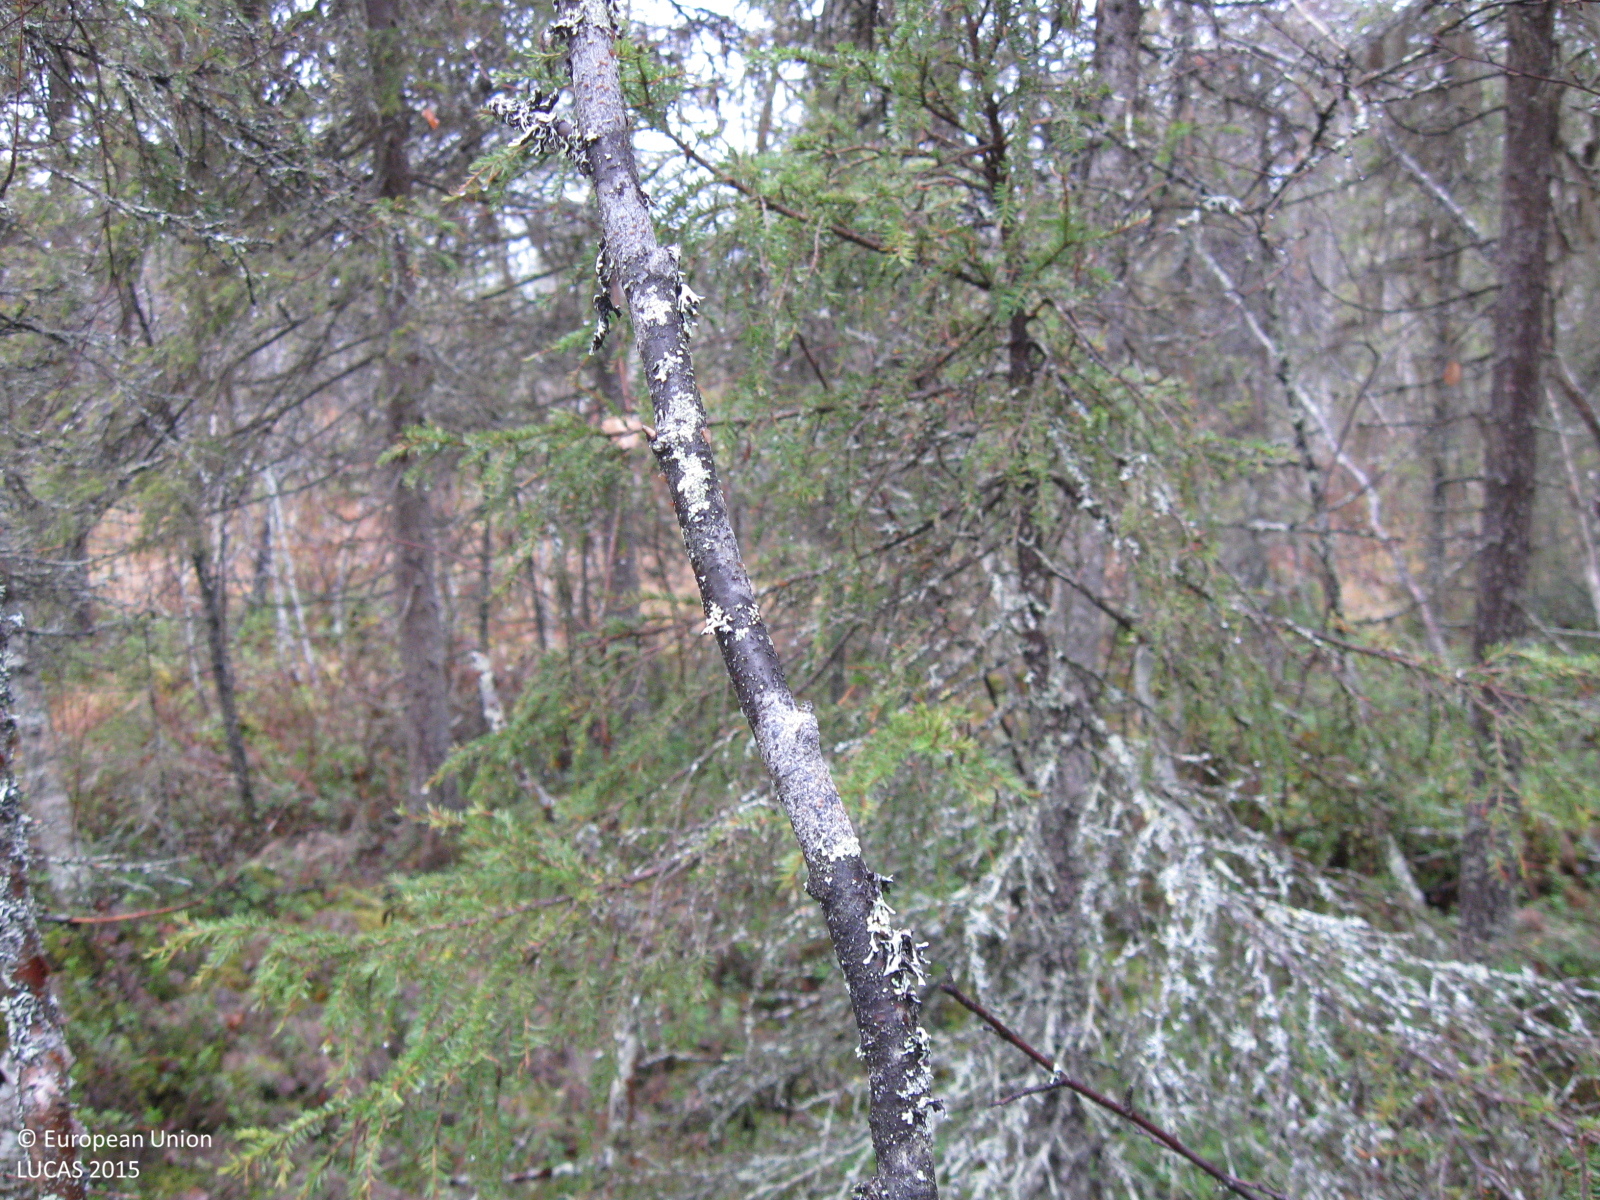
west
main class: Woodland
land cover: Spruce dominated mixed woodland
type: boreal forest
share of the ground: > 75 %
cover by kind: coniferous forest trees 50 %, broadleaved forest trees 30 %, shrubs 10 %, herbaceous plants 5 %, lichens and mosses 5 %
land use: Forestry
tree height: > 5 m
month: October
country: SE
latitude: 66.7548
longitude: 21.0596
